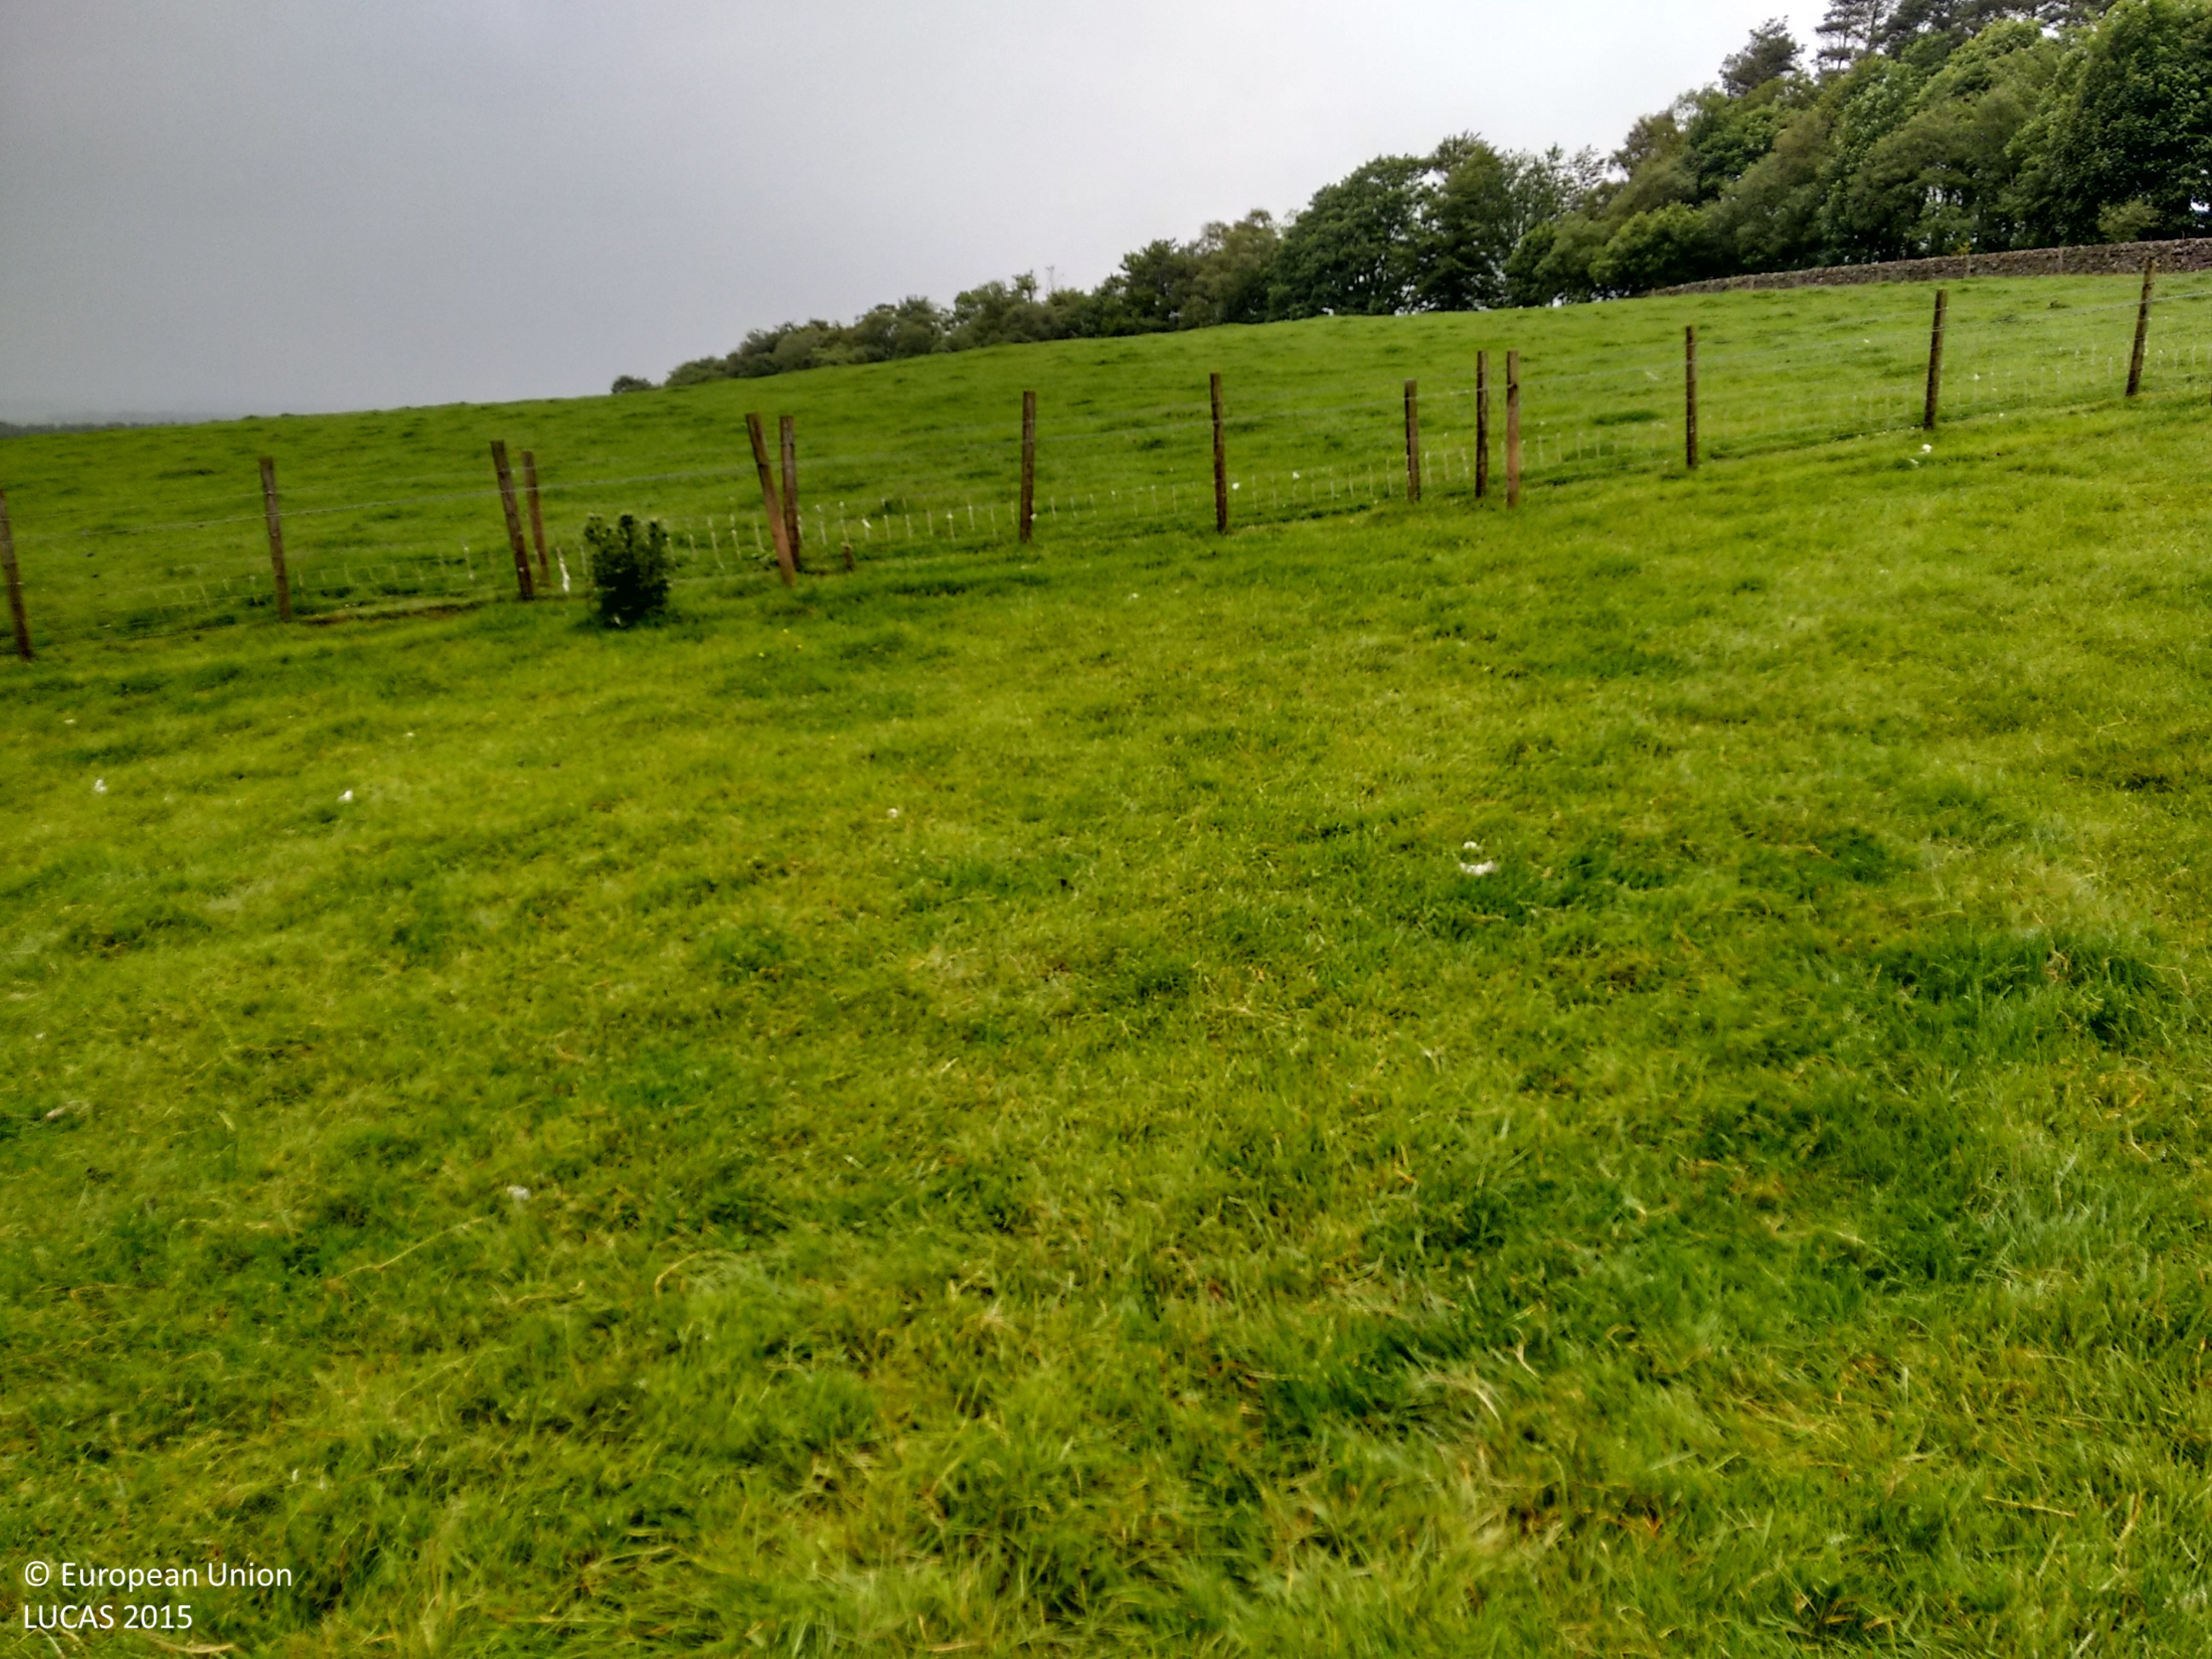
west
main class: Grassland
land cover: Grassland without tree/shrub cover
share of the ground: > 75 %
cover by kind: herbaceous plants 100 %
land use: Agriculture (excluding fallow land and kitchen gardens)
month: June
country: GB
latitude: 55.0353
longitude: -3.2981
